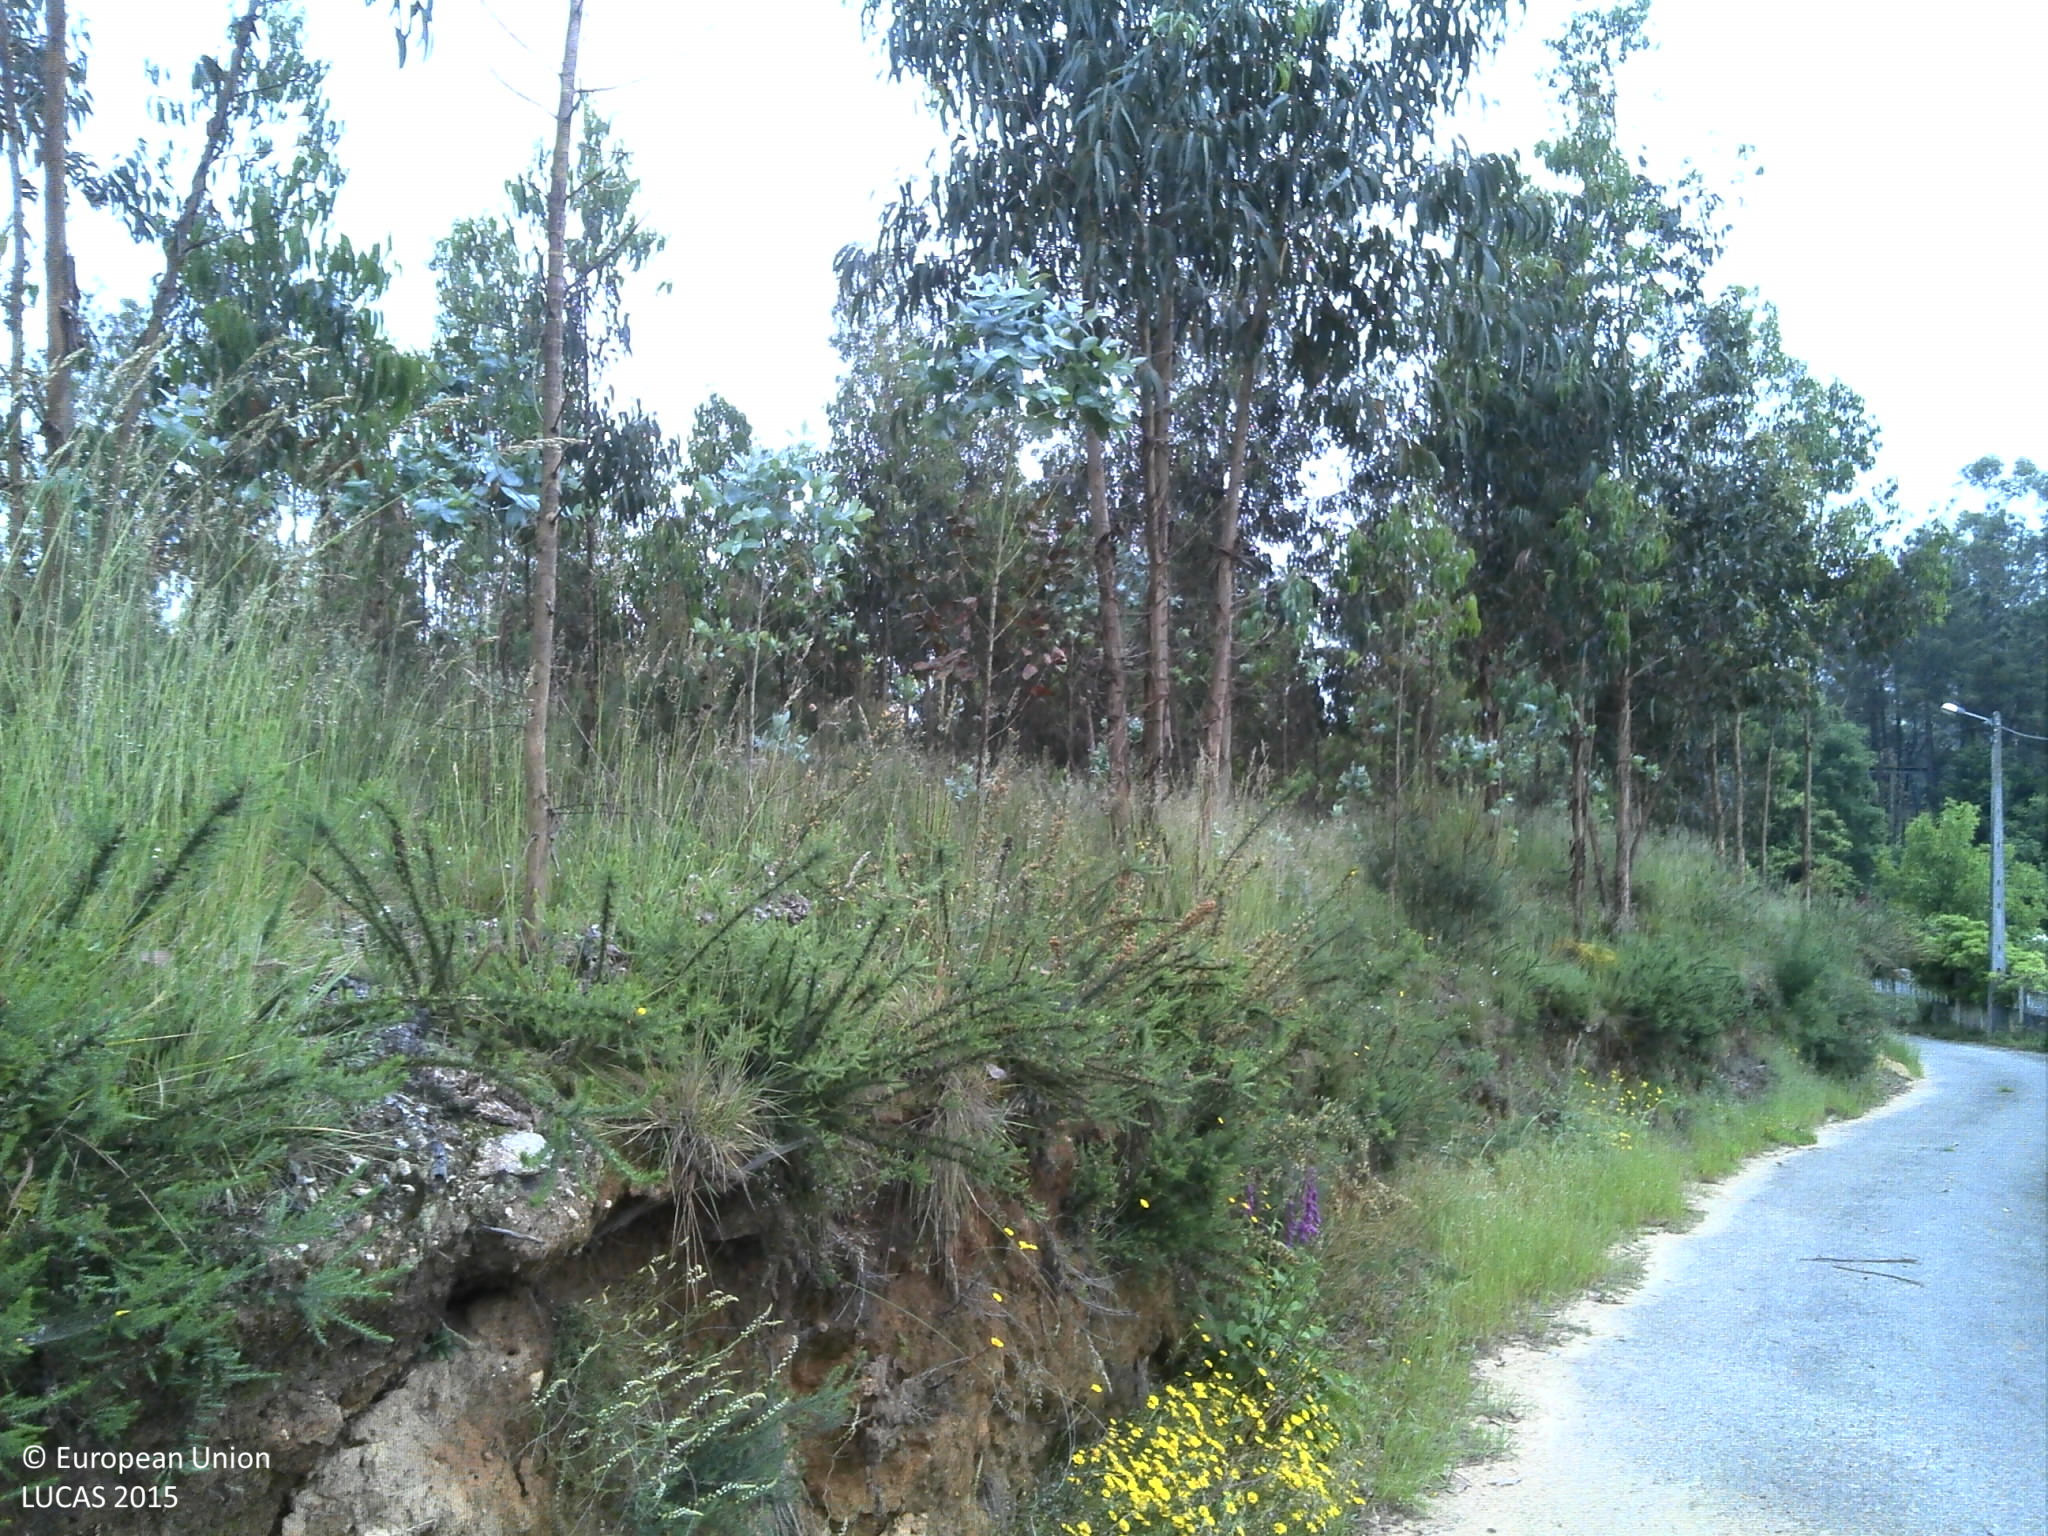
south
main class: Cropland
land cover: Temporary grasslands
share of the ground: > 75 %
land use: Agriculture (excluding fallow land and kitchen gardens)
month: May
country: PT
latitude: 40.8588
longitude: -8.4966
